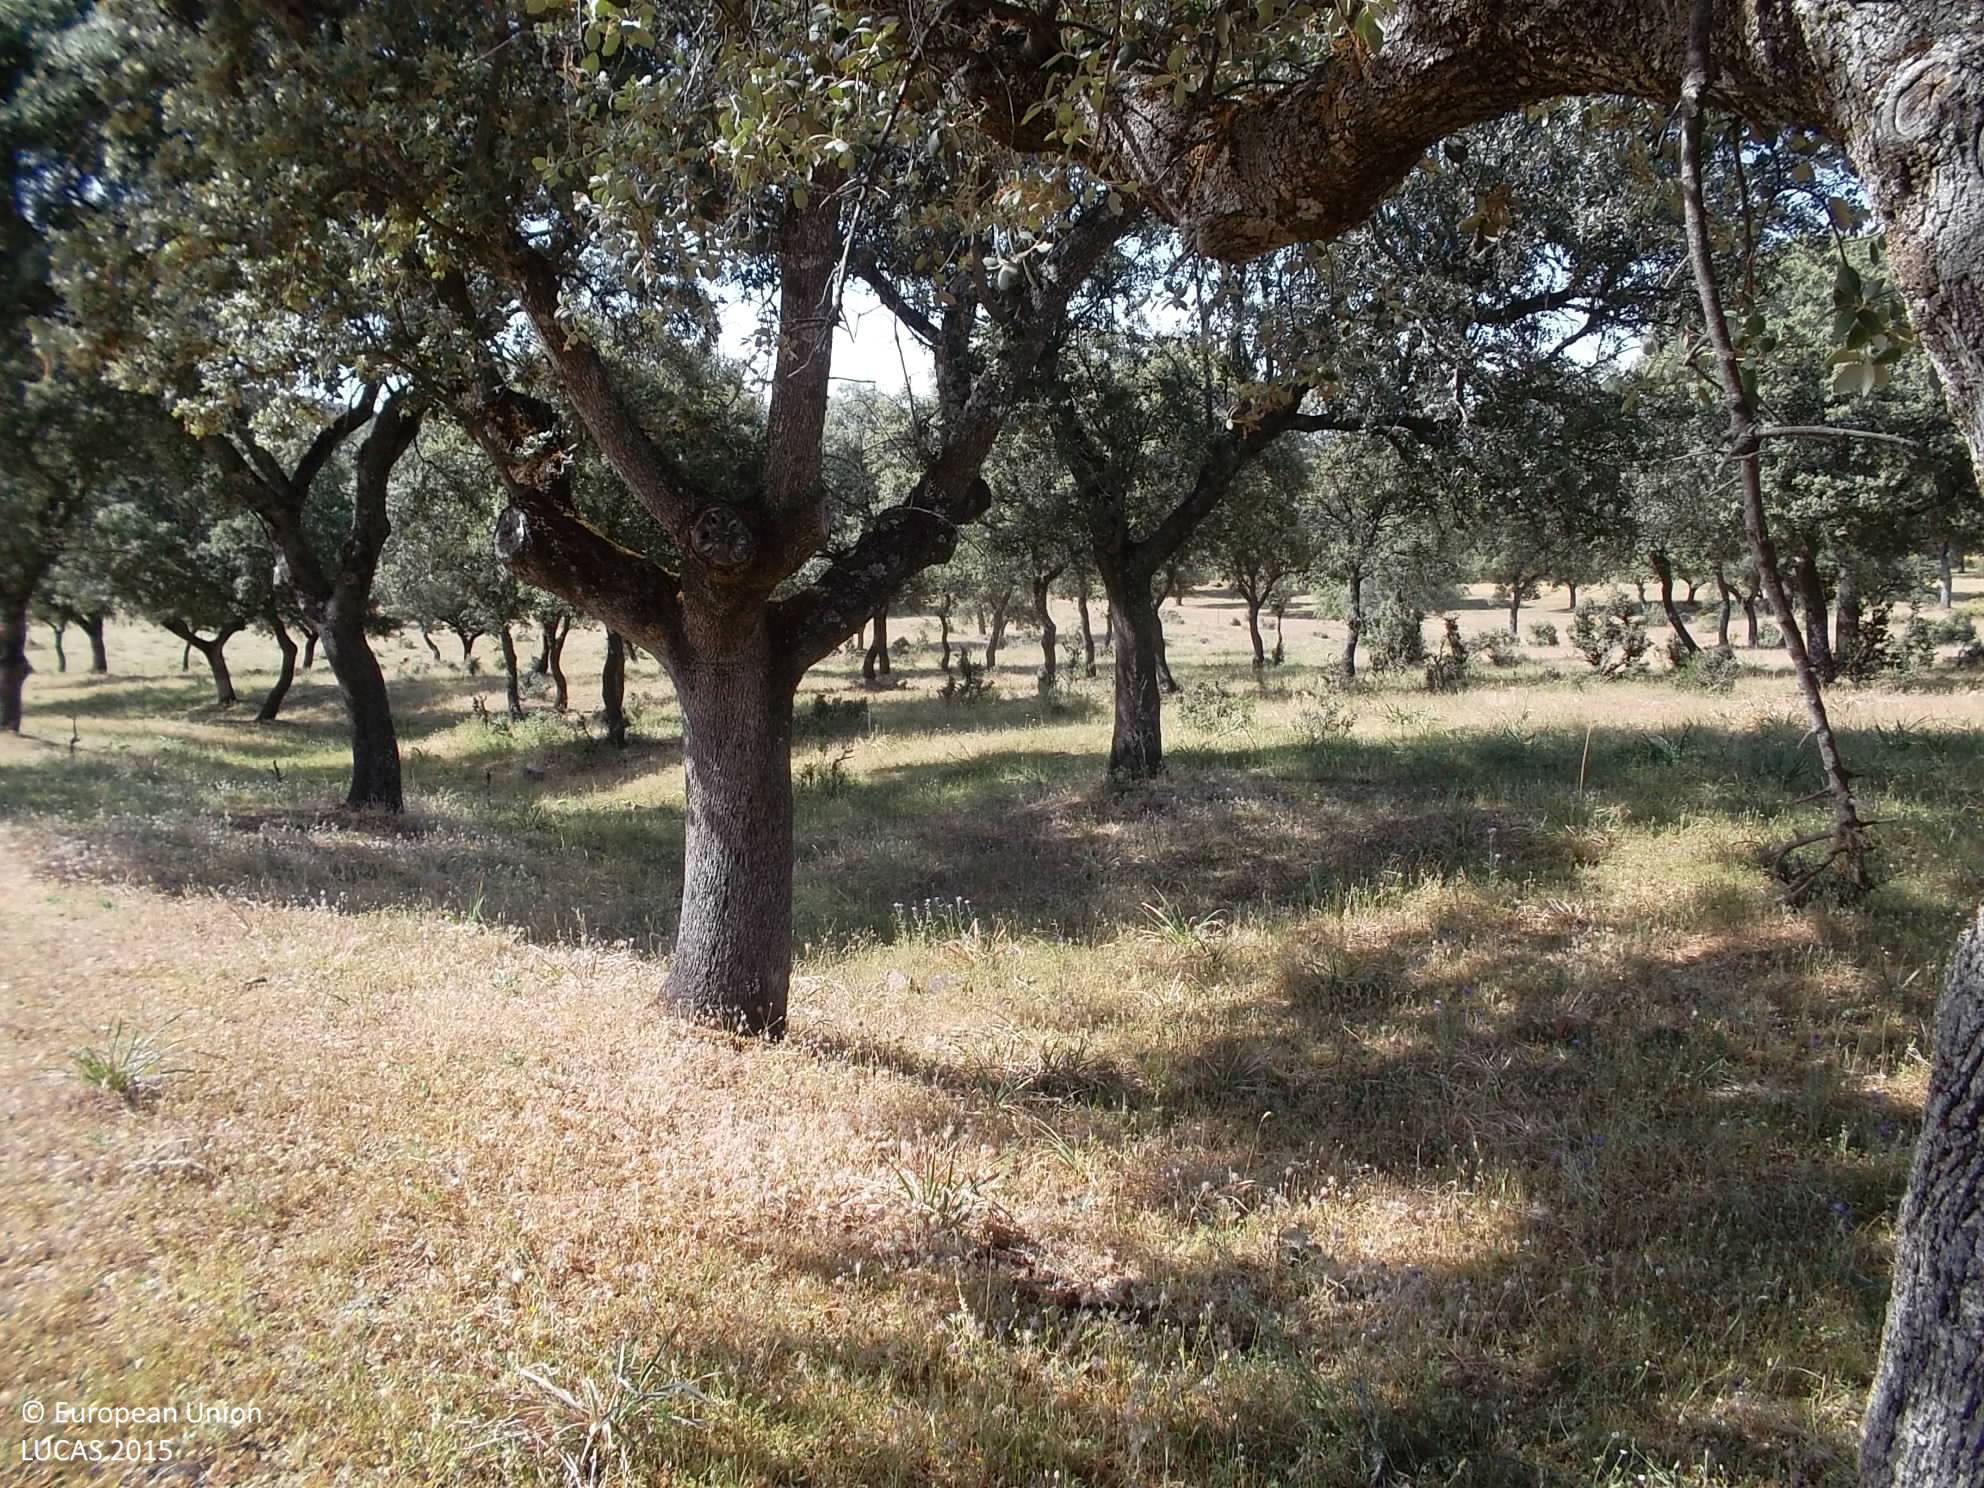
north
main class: Woodland
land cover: Broadleaved woodland
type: broadleaved evergreen forest
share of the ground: 25 - 50 %
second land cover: Spontaneously vegetated surfaces
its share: > 75 %
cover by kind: herbaceous plants 60 %, broadleaved forest trees 40 %
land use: Forestry
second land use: Agriculture (excluding fallow land and kitchen gardens)
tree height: > 5 m
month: May
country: ES
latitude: 38.7985
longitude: -4.4984
